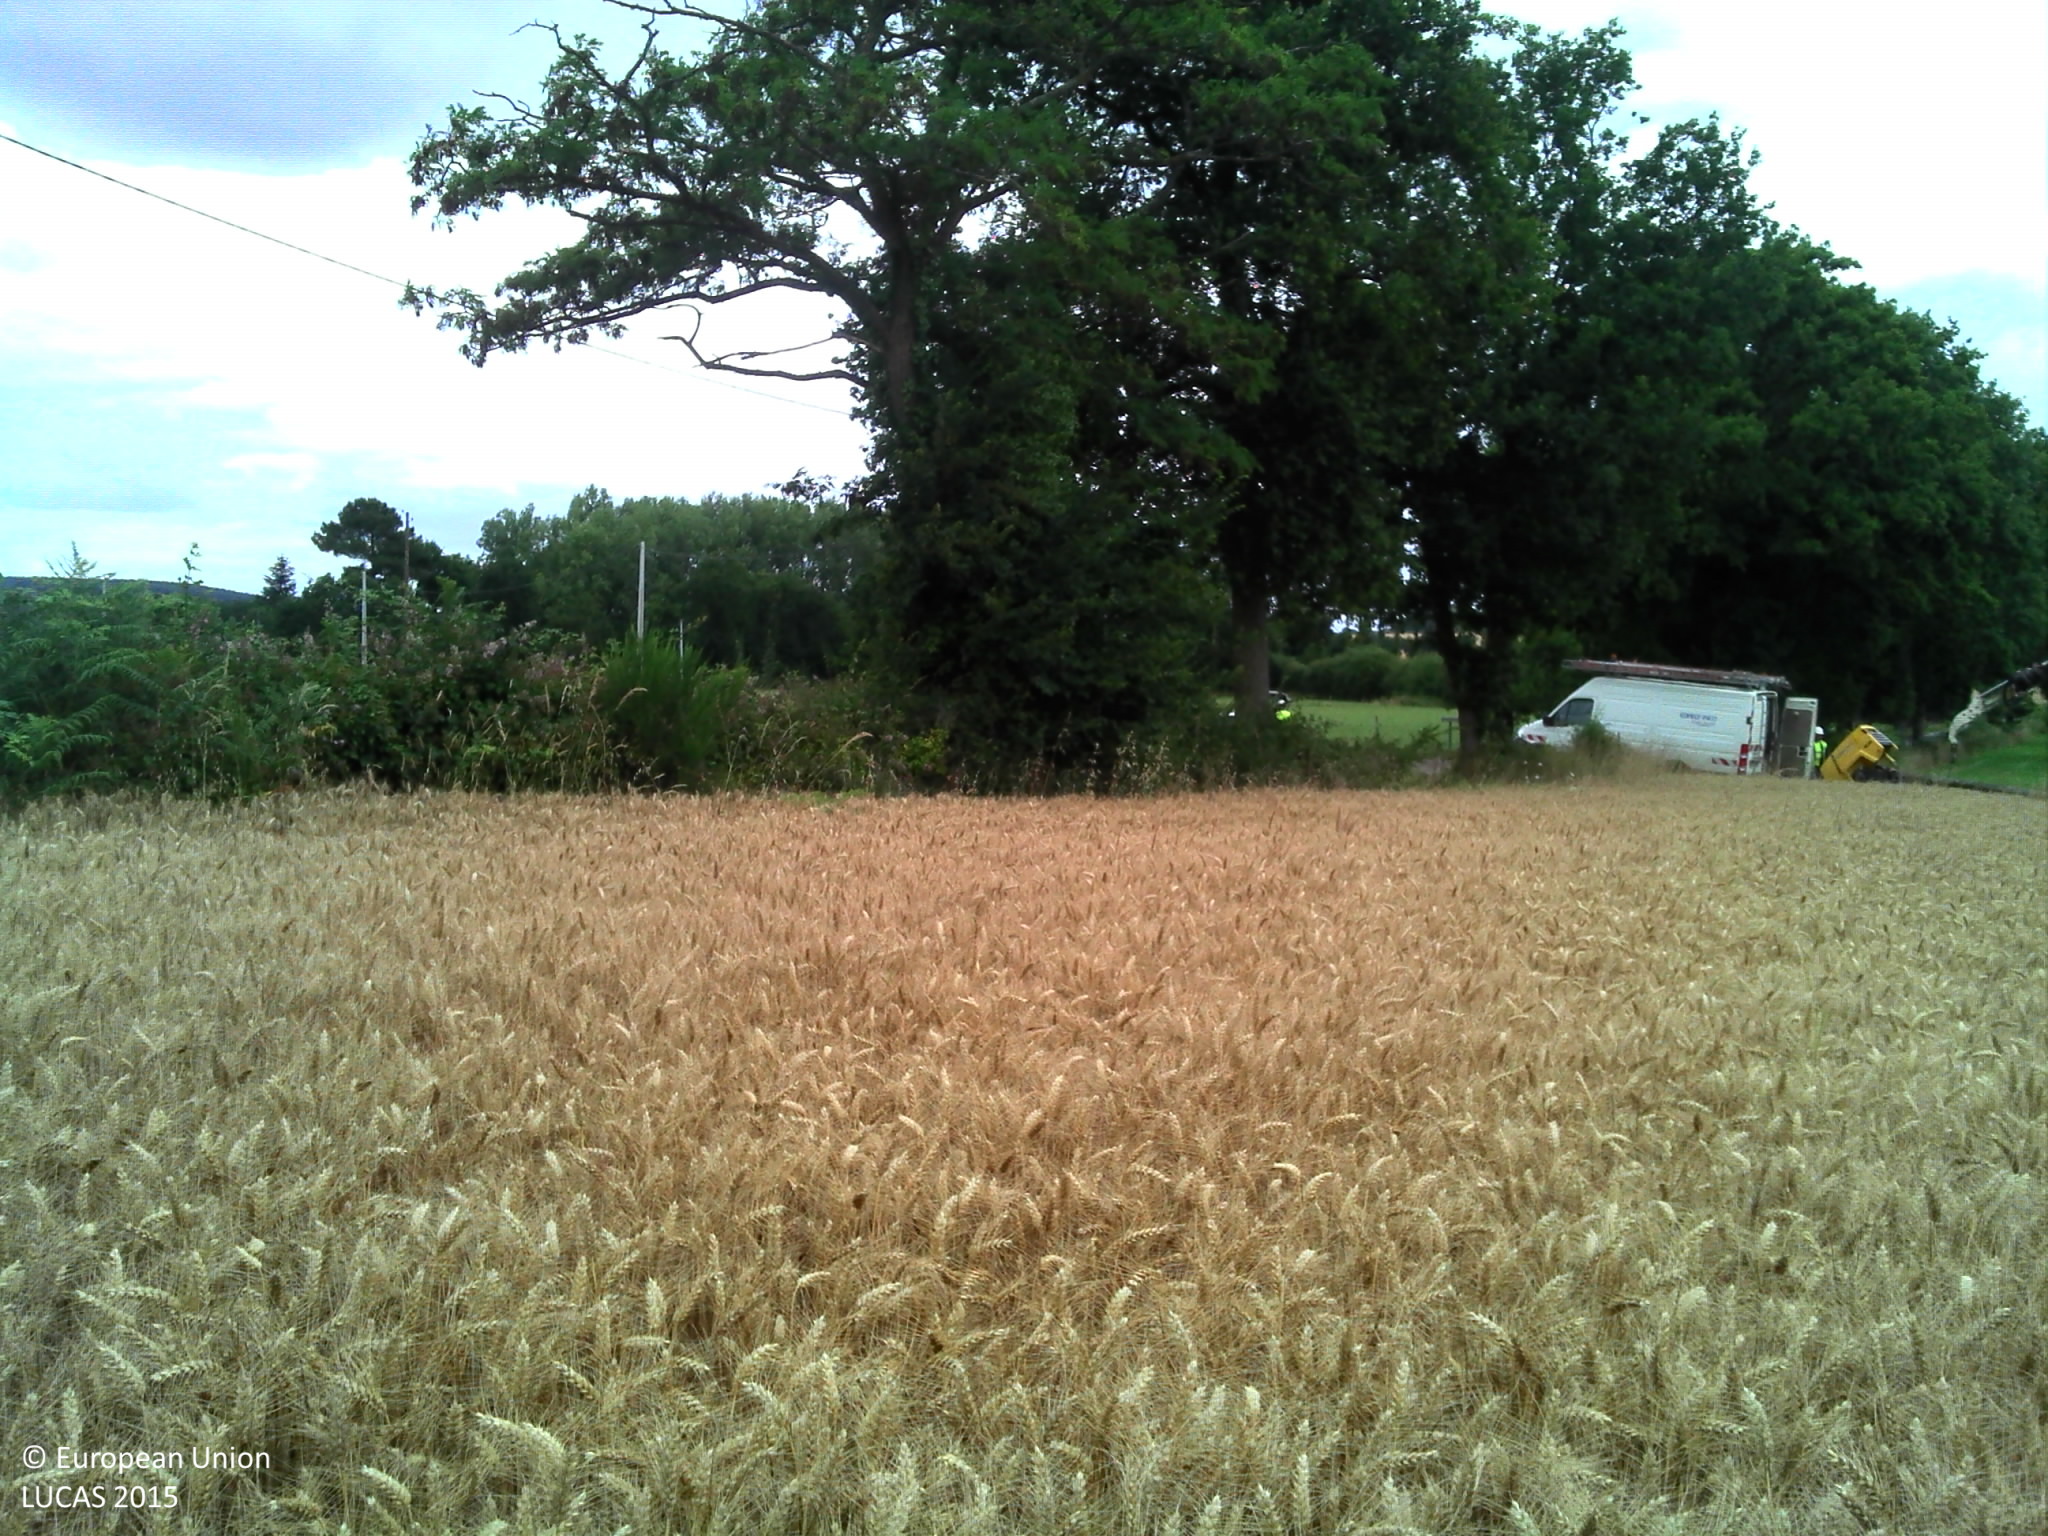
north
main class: Cropland
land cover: Durum wheat
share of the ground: > 75 %
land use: Agriculture (excluding fallow land and kitchen gardens)
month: July
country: FR
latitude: 47.7959
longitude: -2.0536
